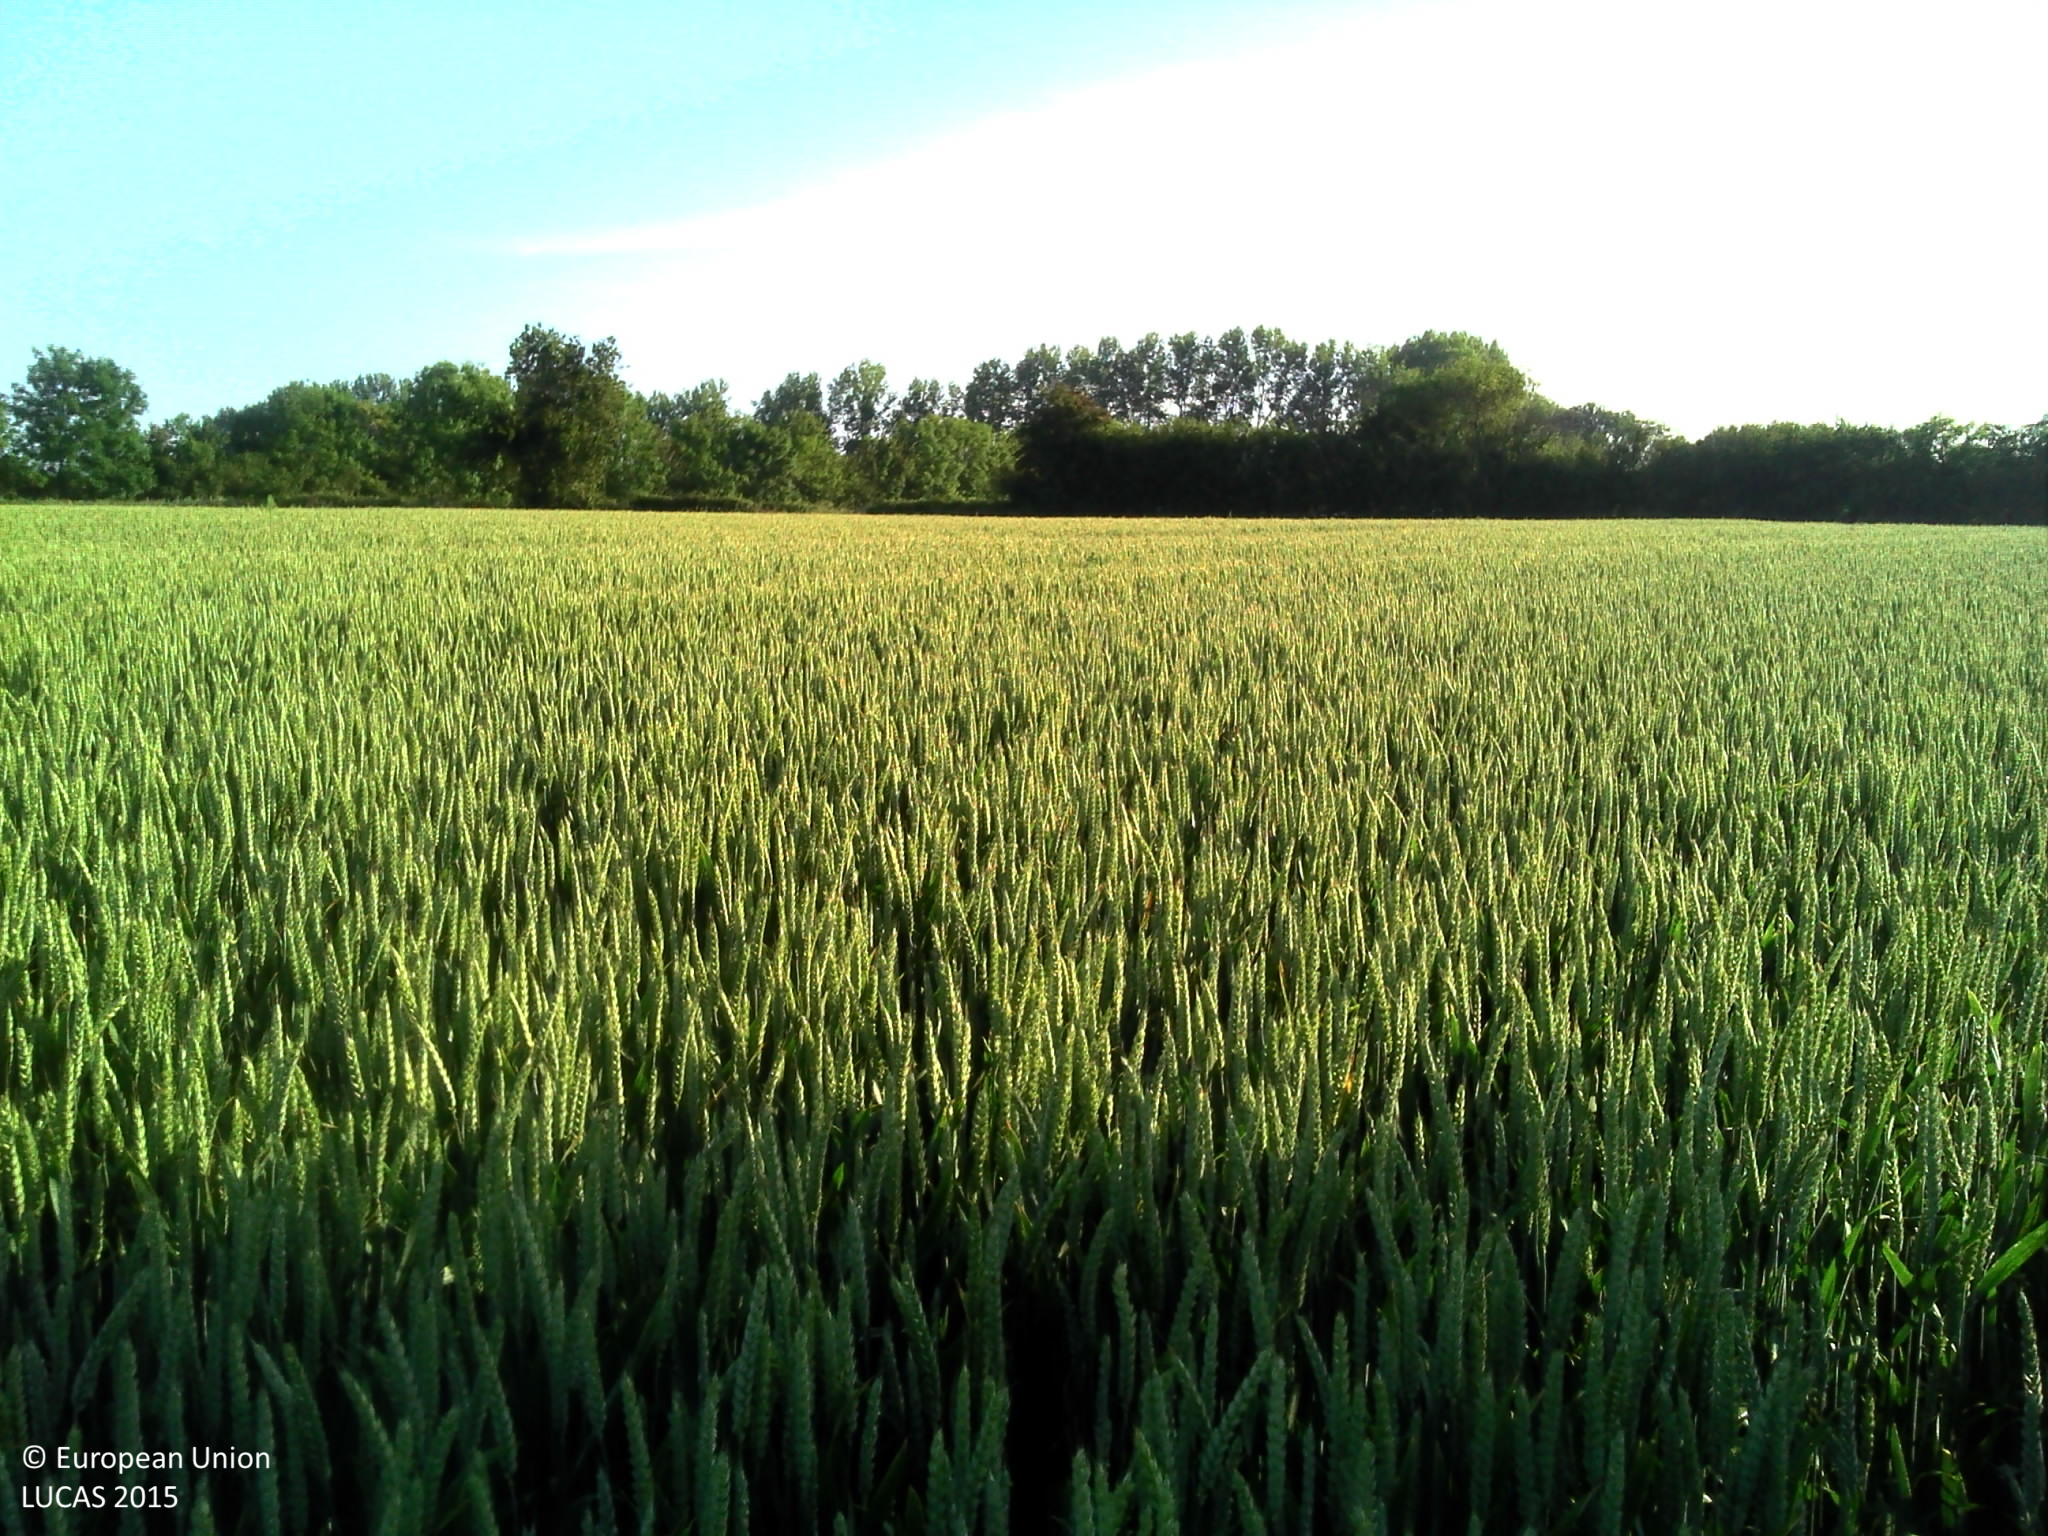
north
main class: Cropland
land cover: Common wheat
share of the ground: > 75 %
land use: Agriculture (excluding fallow land and kitchen gardens)
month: June
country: FR
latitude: 49.3404
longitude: -1.3745
